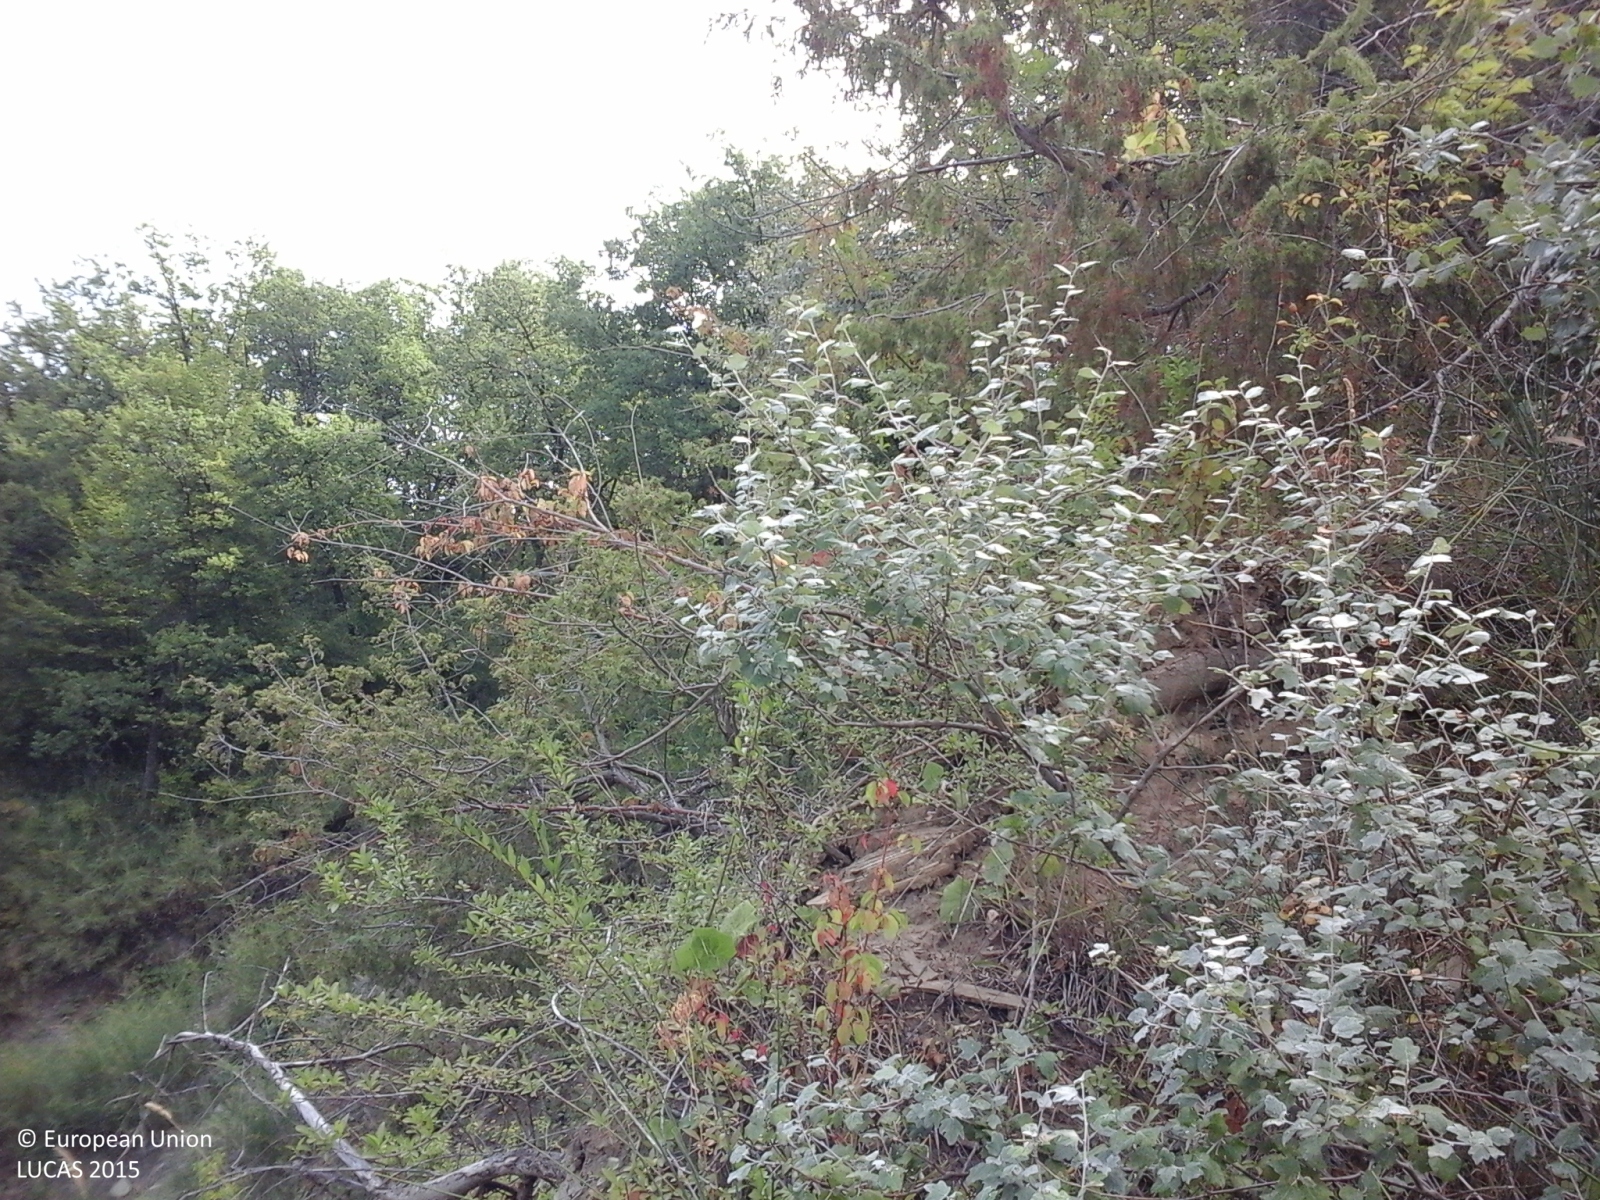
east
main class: Shrubland
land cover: Shrubland without tree cover
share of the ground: > 75 %
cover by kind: shrubs 100 %
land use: Semi-natural and natural areas not in use
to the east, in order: Shrubland without tree cover; Shrubland with sparse tree cover; Broadleaved woodland; Ditches and canals; Broadleaved woodland; Other bare soil; Lucerne; Spontaneously vegetated surfaces; Lucerne; Other bare soil
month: August
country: IT
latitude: 43.0114
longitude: 13.4381
